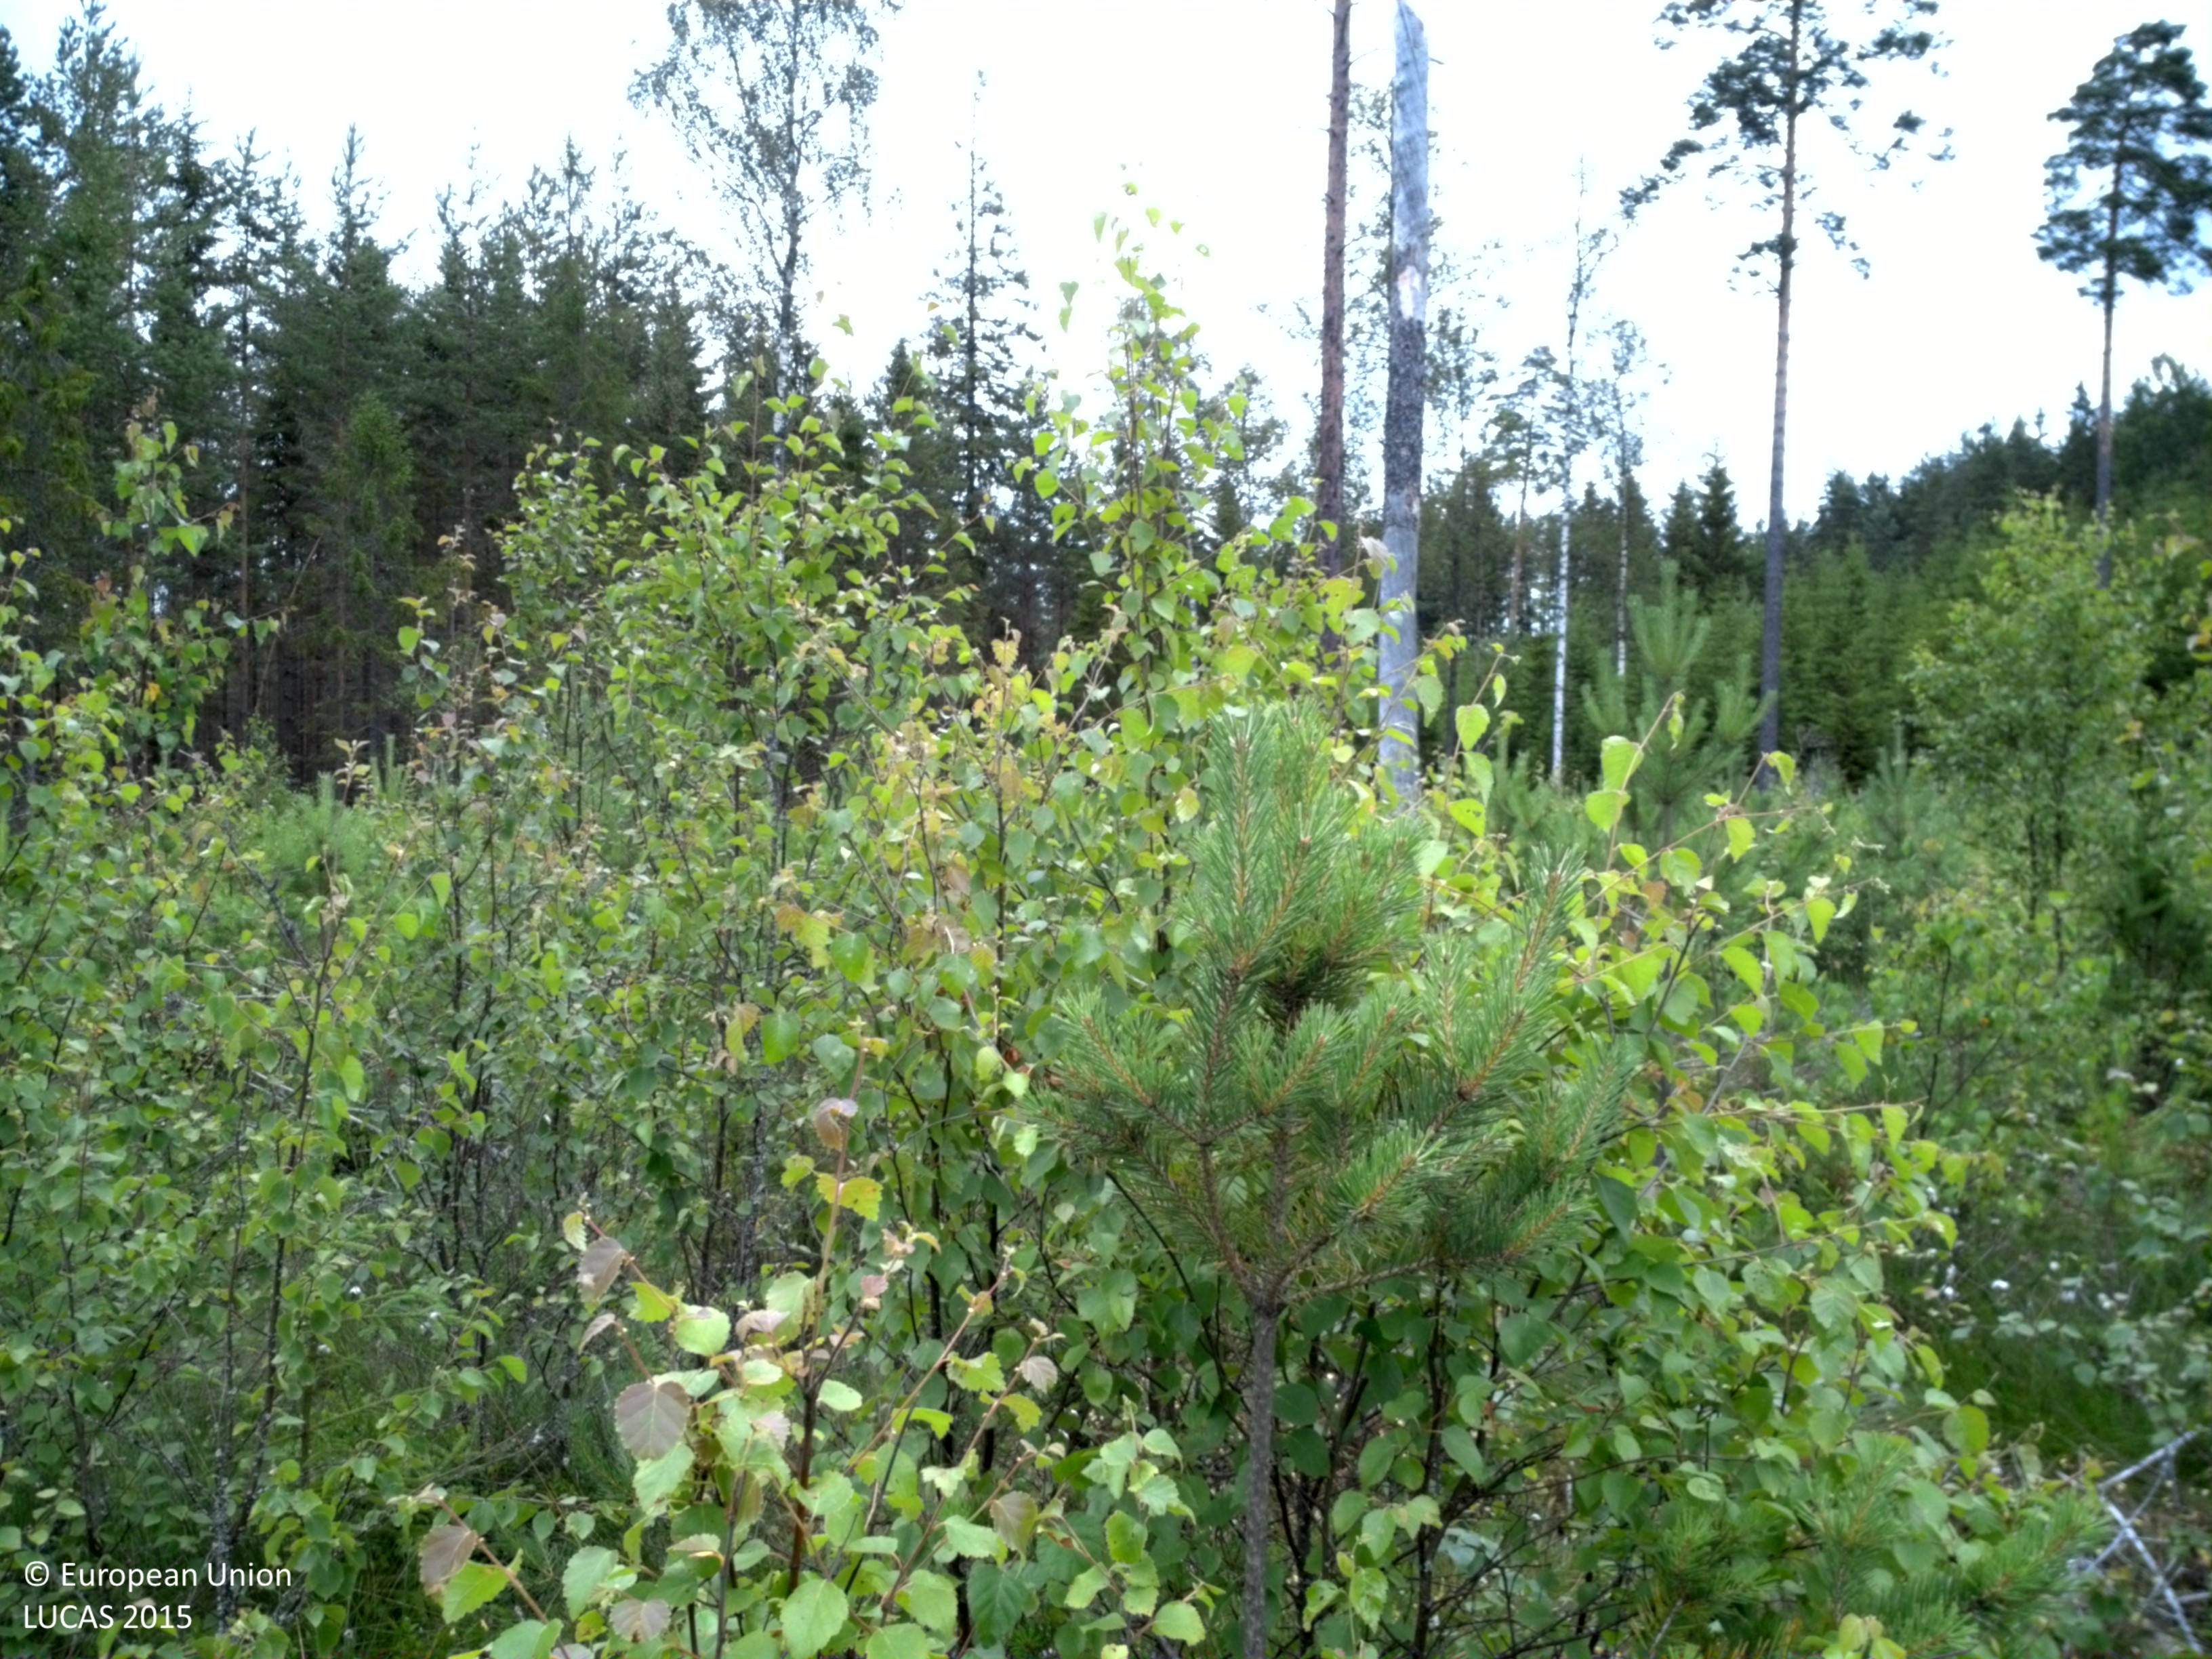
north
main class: Woodland
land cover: Pine dominated mixed woodland
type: boreal forest
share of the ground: 50 - 75 %
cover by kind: coniferous forest trees 45 %, broadleaved forest trees 25 %, herbaceous plants 25 %, shrubs 5 %
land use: Forestry
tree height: > 5 m
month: July
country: SE
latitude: 58.9542
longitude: 14.5297
